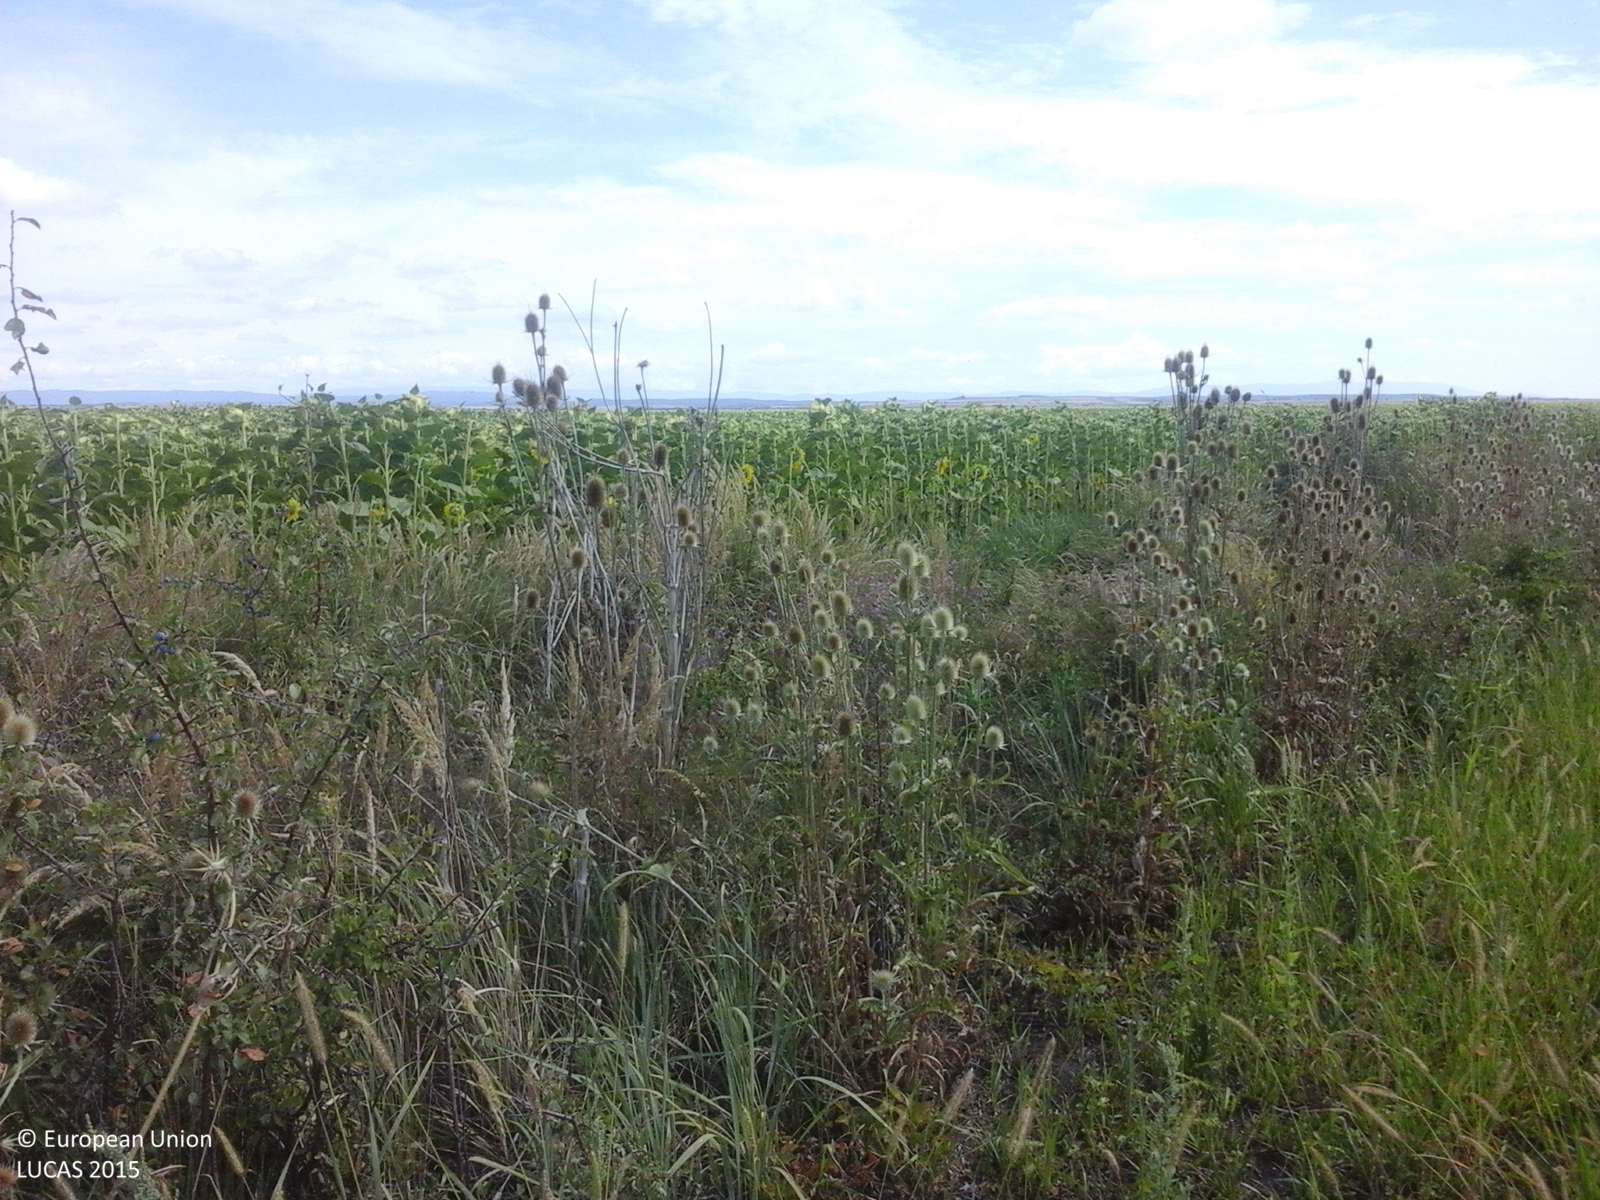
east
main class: Cropland
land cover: Sunflower
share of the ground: > 75 %
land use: Agriculture (excluding fallow land and kitchen gardens)
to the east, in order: Sunflower; Grass margins; Tracks; Grass margins; Abandoned hedges; Ditches and canals; Grass margins; Sunflower
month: August
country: RO
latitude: 45.3039
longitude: 21.3932
